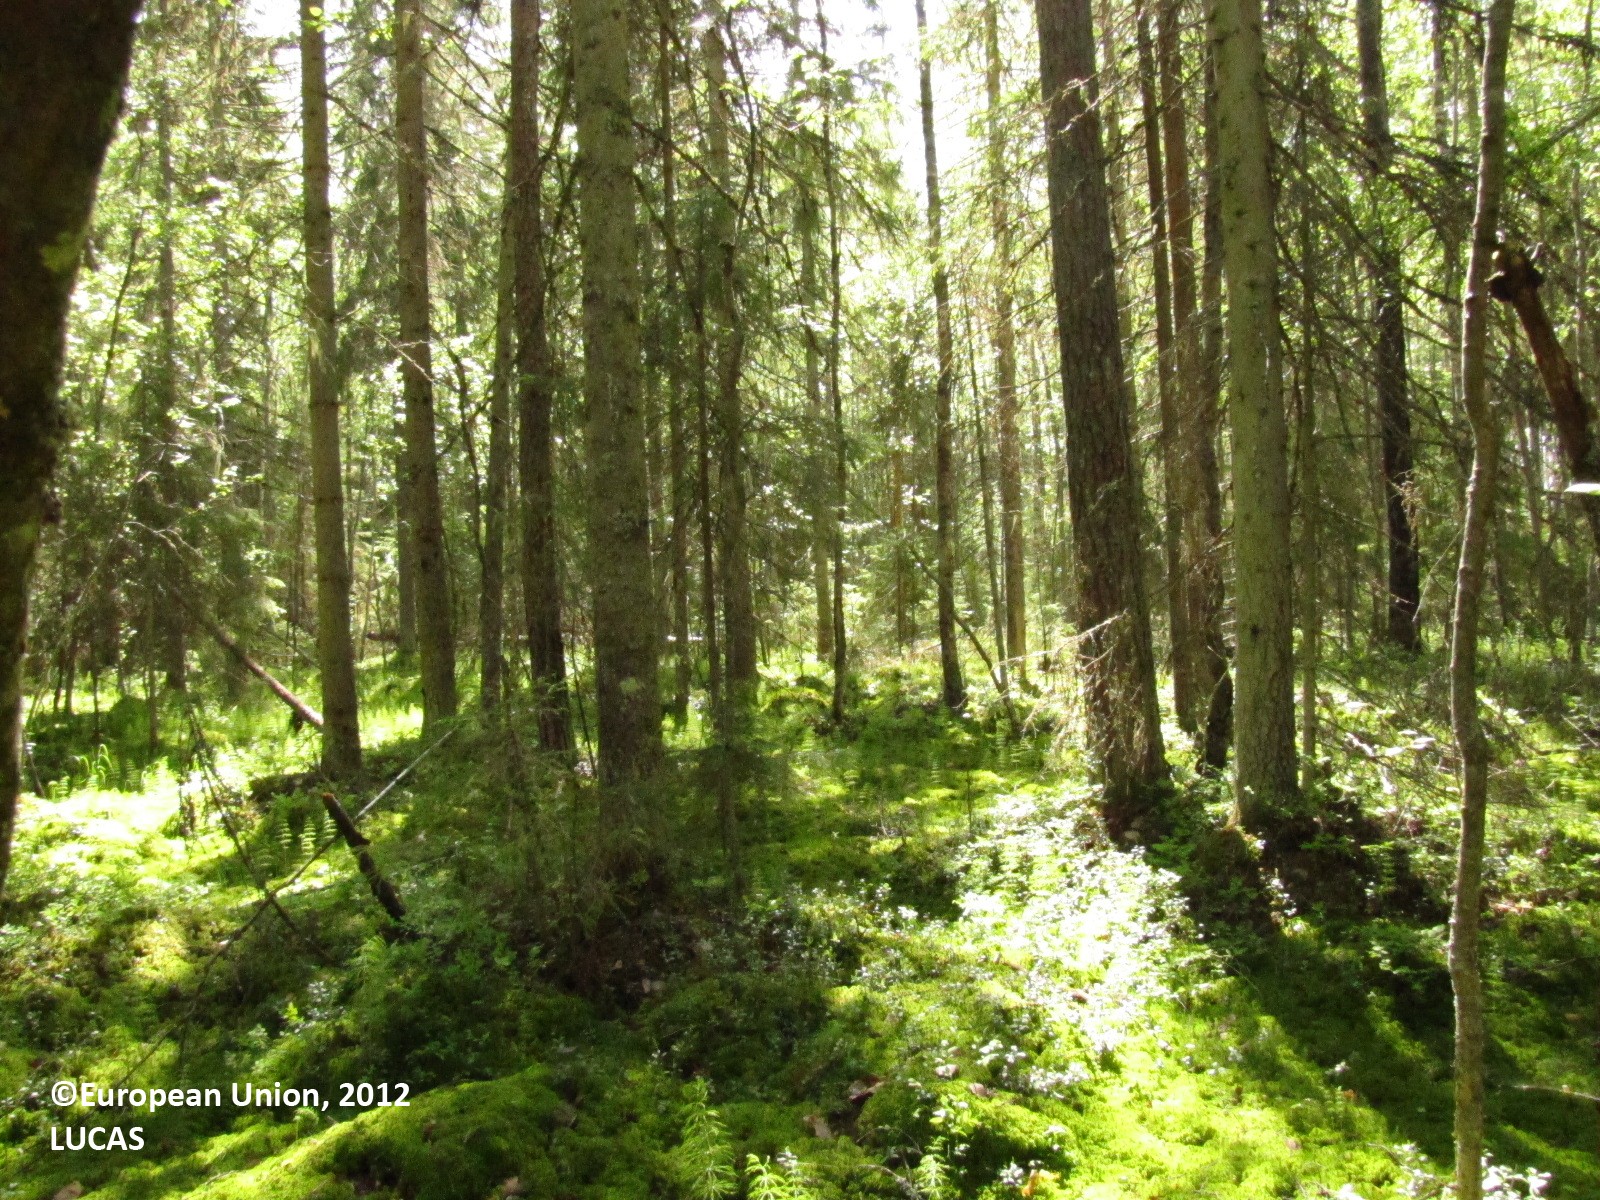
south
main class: Woodland
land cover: Spruce dominated coniferous woodland
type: boreal forest
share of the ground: > 75 %
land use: Forestry
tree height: > 5 m
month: June
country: FI
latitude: 61.6474
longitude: 23.1535
